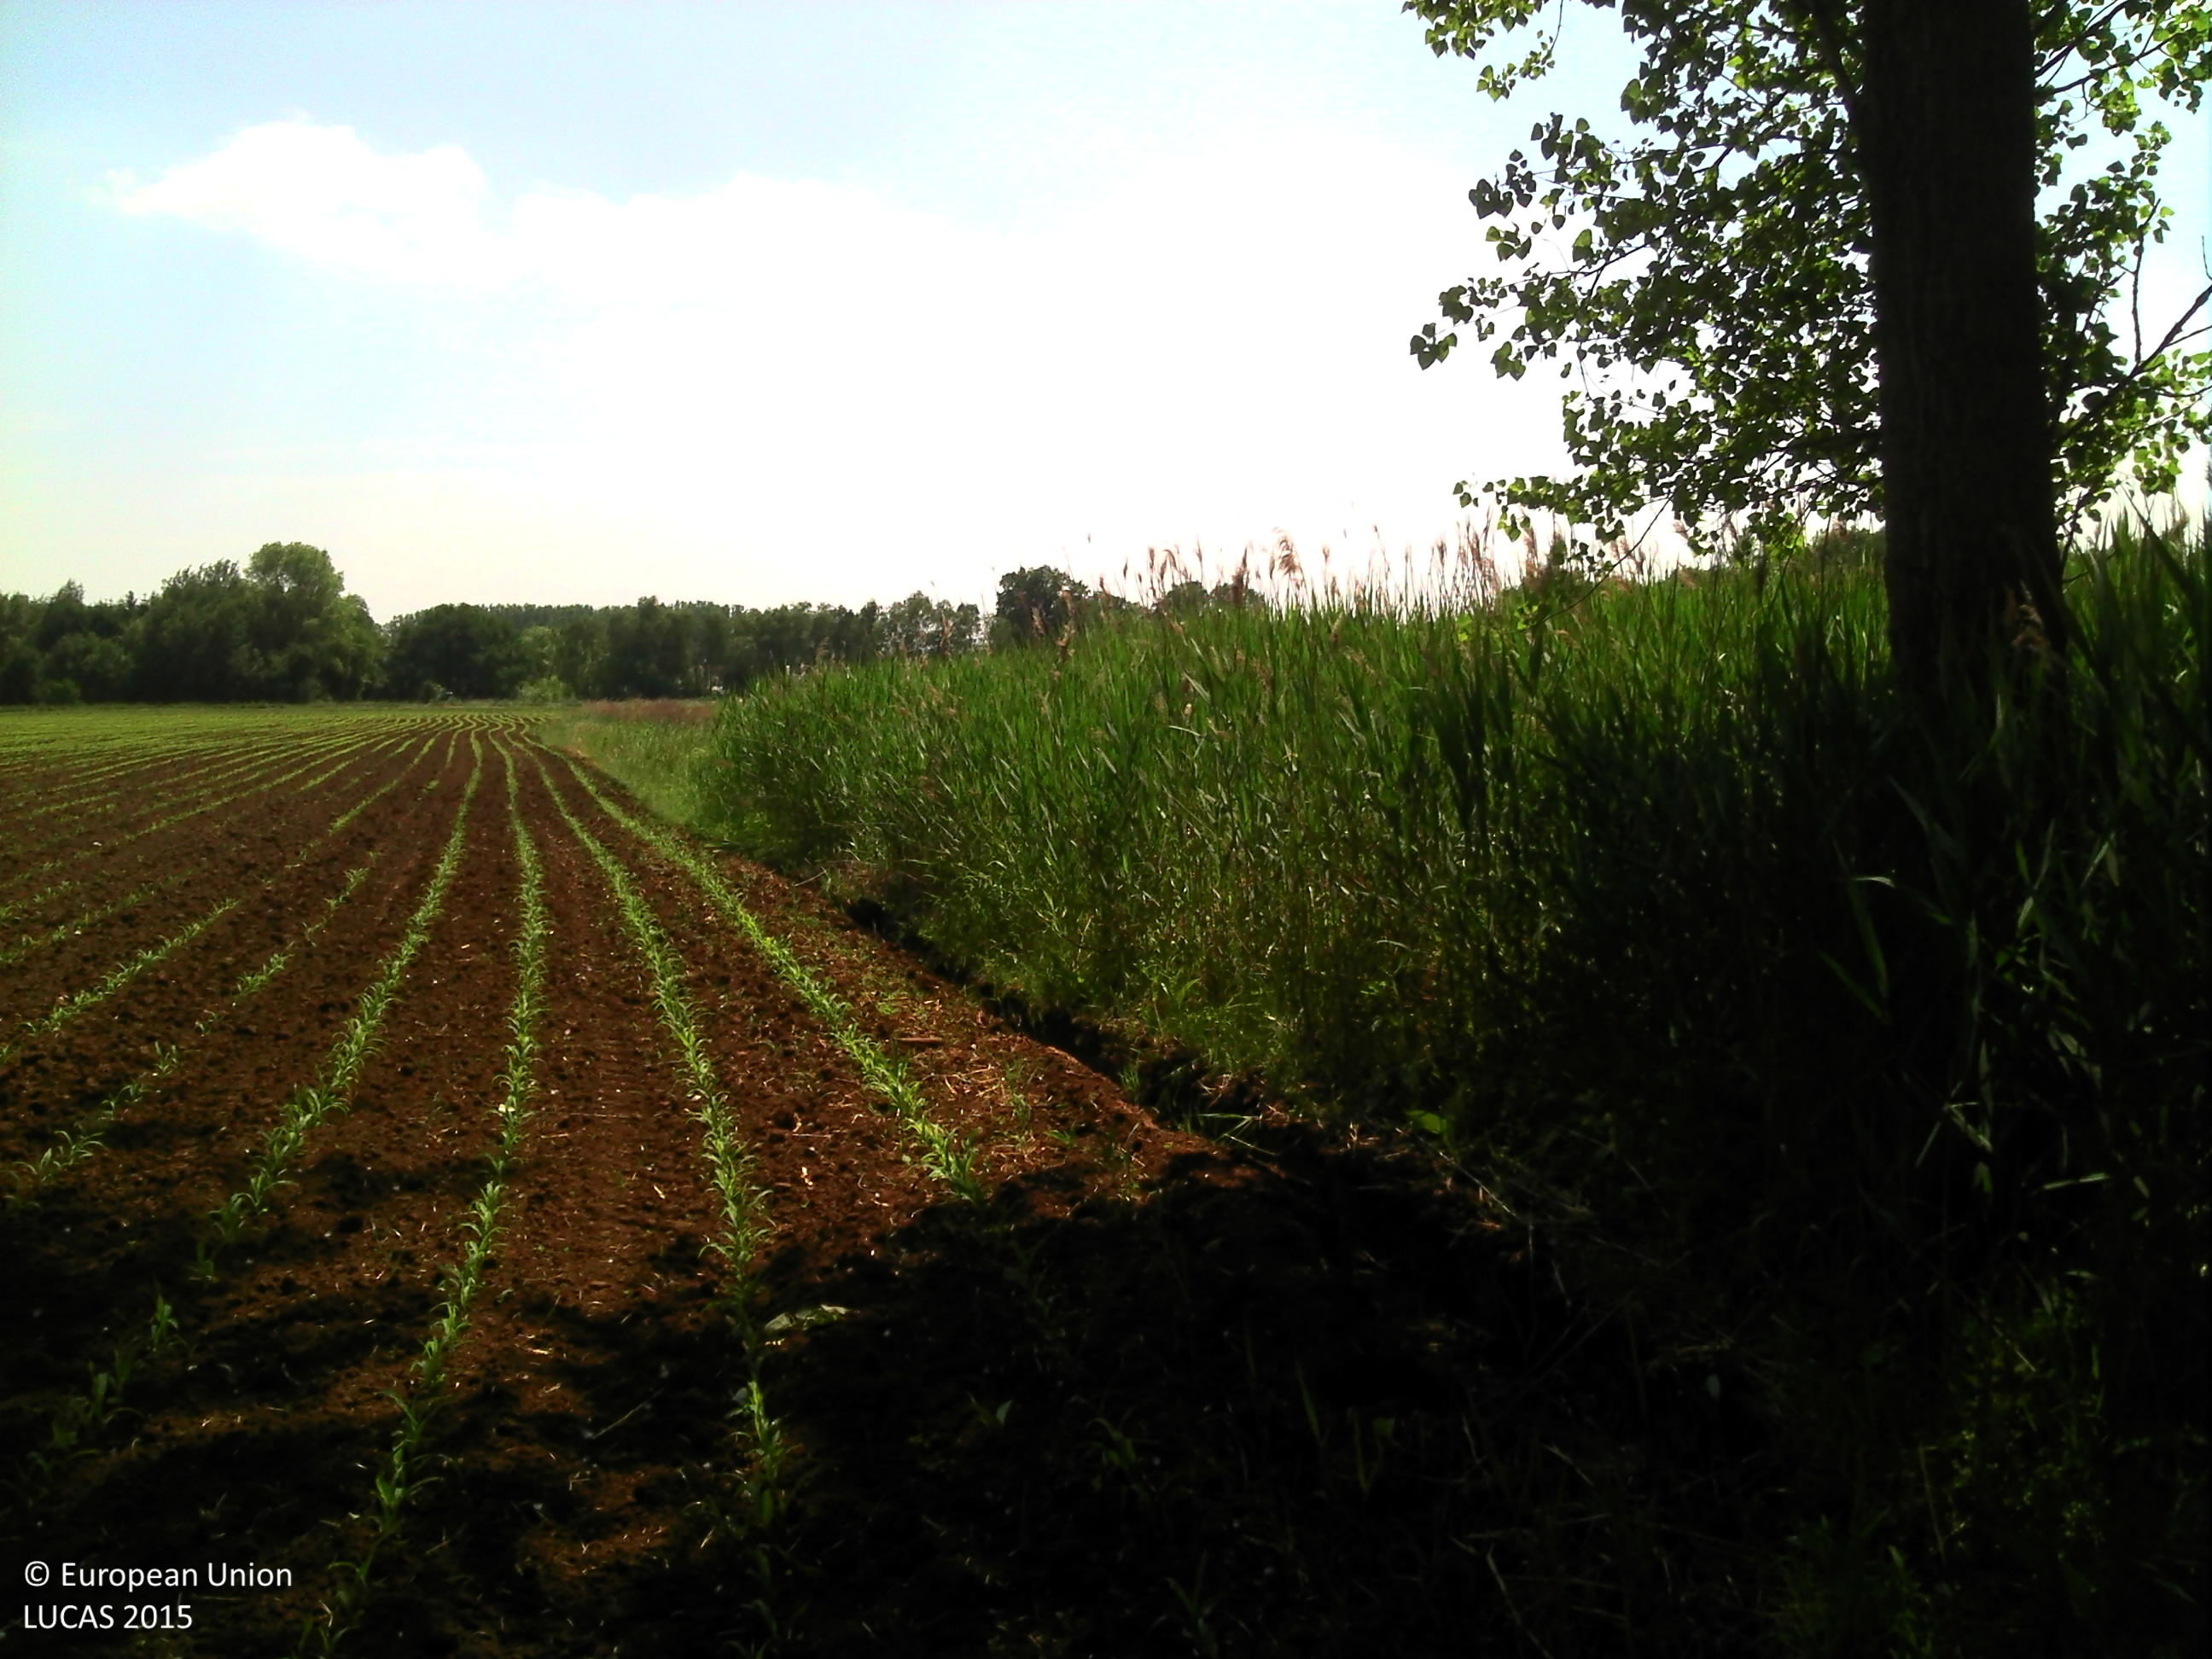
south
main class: Cropland
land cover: Maize
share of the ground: > 75 %
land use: Agriculture (excluding fallow land and kitchen gardens)
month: June
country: BE
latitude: 50.9669
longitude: 5.2273
